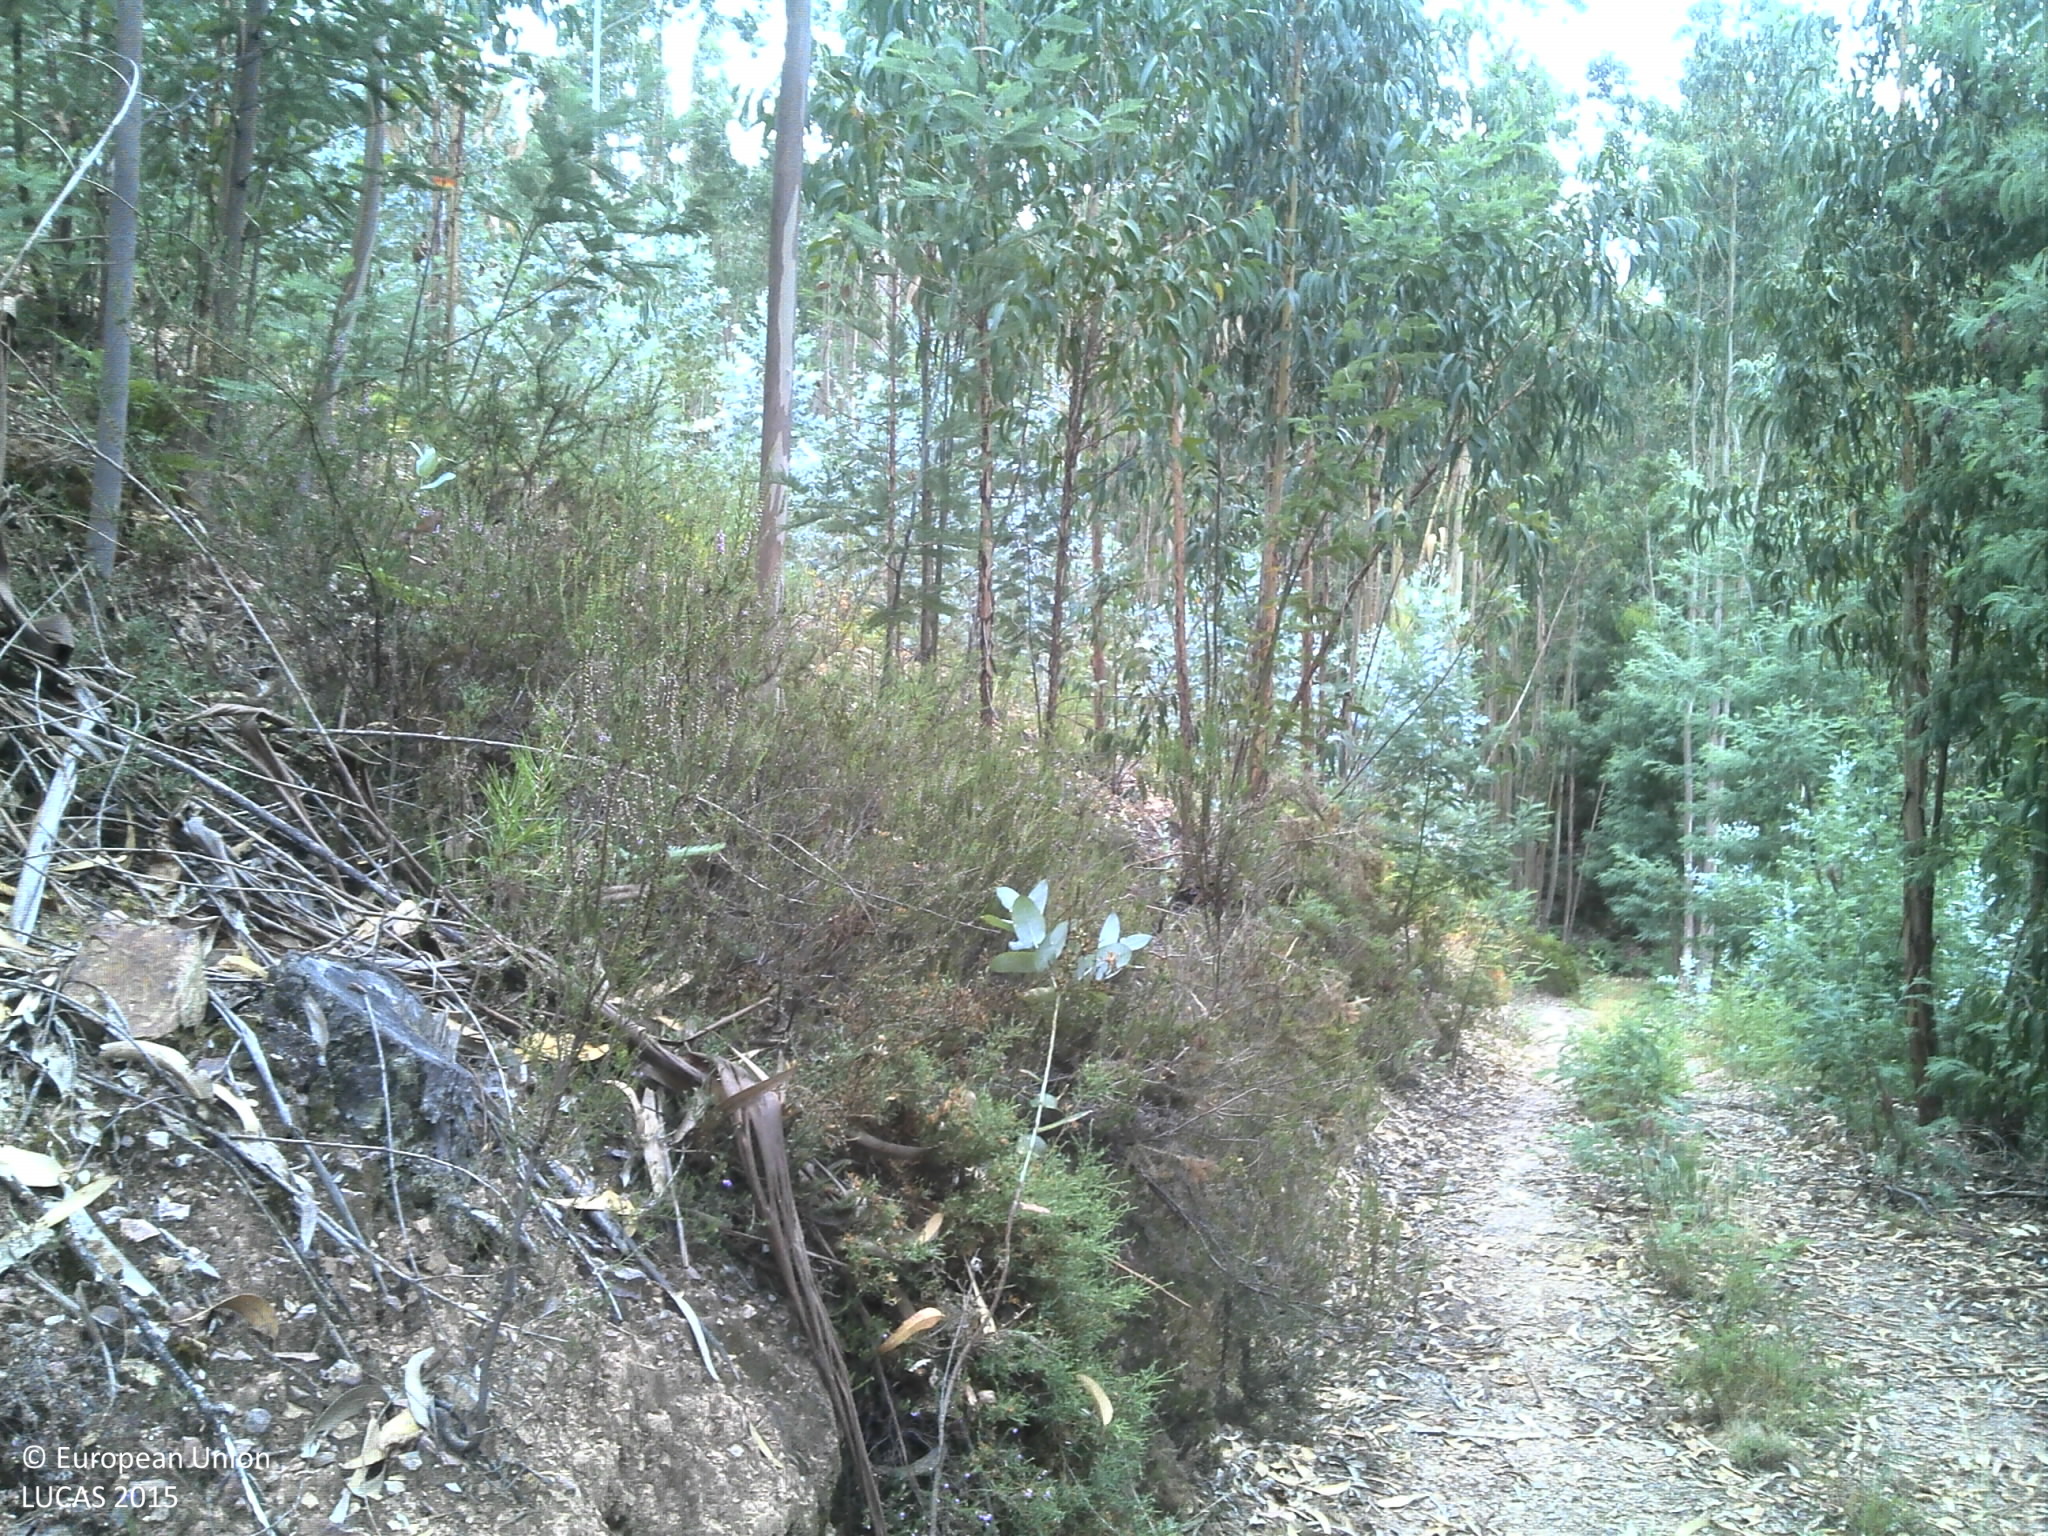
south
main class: Woodland
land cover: Broadleaved woodland
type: exotic forest
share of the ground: 50 - 75 %
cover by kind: broadleaved forest trees 60 %, consolidated bare surface 20 %, shrubs 10 %, unconsolidated bare surface 10 %
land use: Forestry
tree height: > 5 m
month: July
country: PT
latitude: 40.2902
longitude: -8.2785
